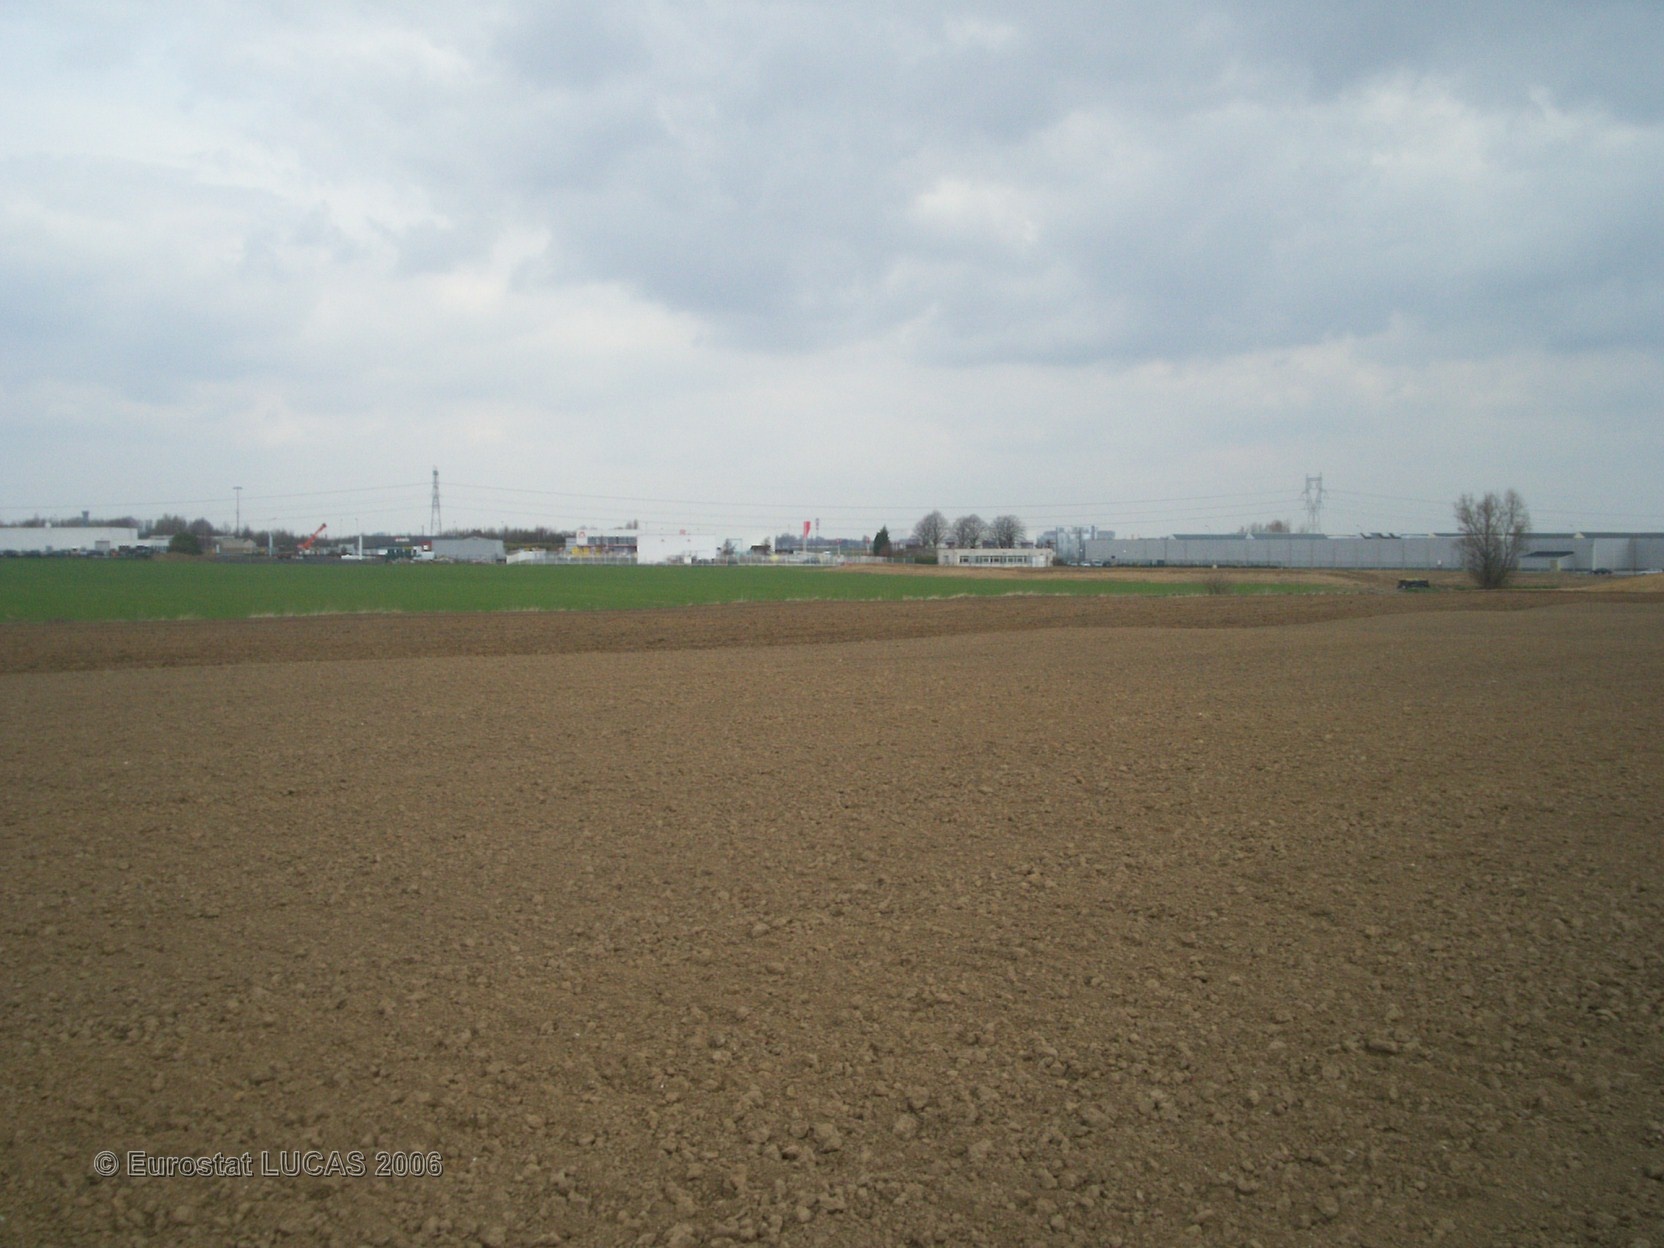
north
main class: Cropland
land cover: Maize
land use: Agriculture (excluding fallow land and kitchen gardens)
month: May
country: FR
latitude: 50.7349
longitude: 2.5489
